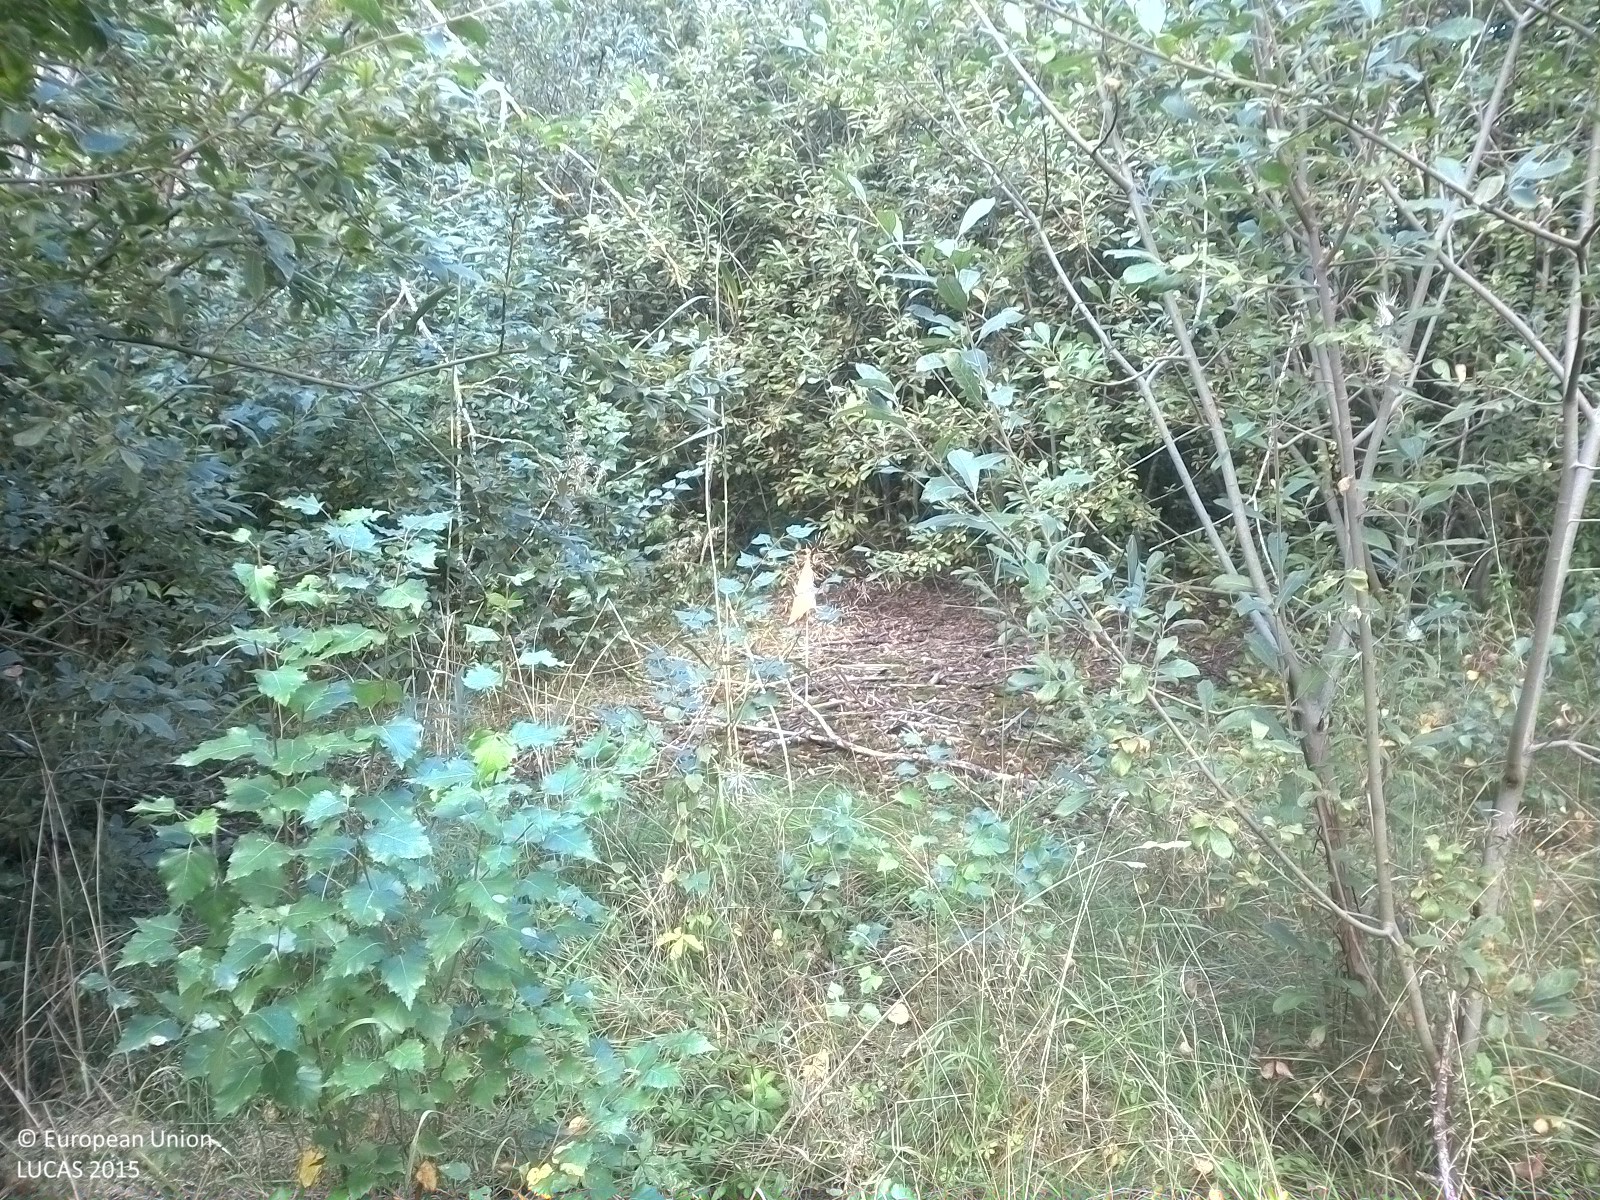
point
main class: Woodland
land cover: Broadleaved woodland
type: hemiboreal forest and nemoral coniferous forest and mixed broadleaved-coniferous forest
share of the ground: 50 - 75 %
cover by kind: broadleaved forest trees 60 %, herbaceous plants 20 %, shrubs 10 %, consolidated bare surface 10 %
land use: Semi-natural and natural areas not in use
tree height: > 5 m
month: September
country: SE
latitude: 58.5996
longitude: 16.2071
